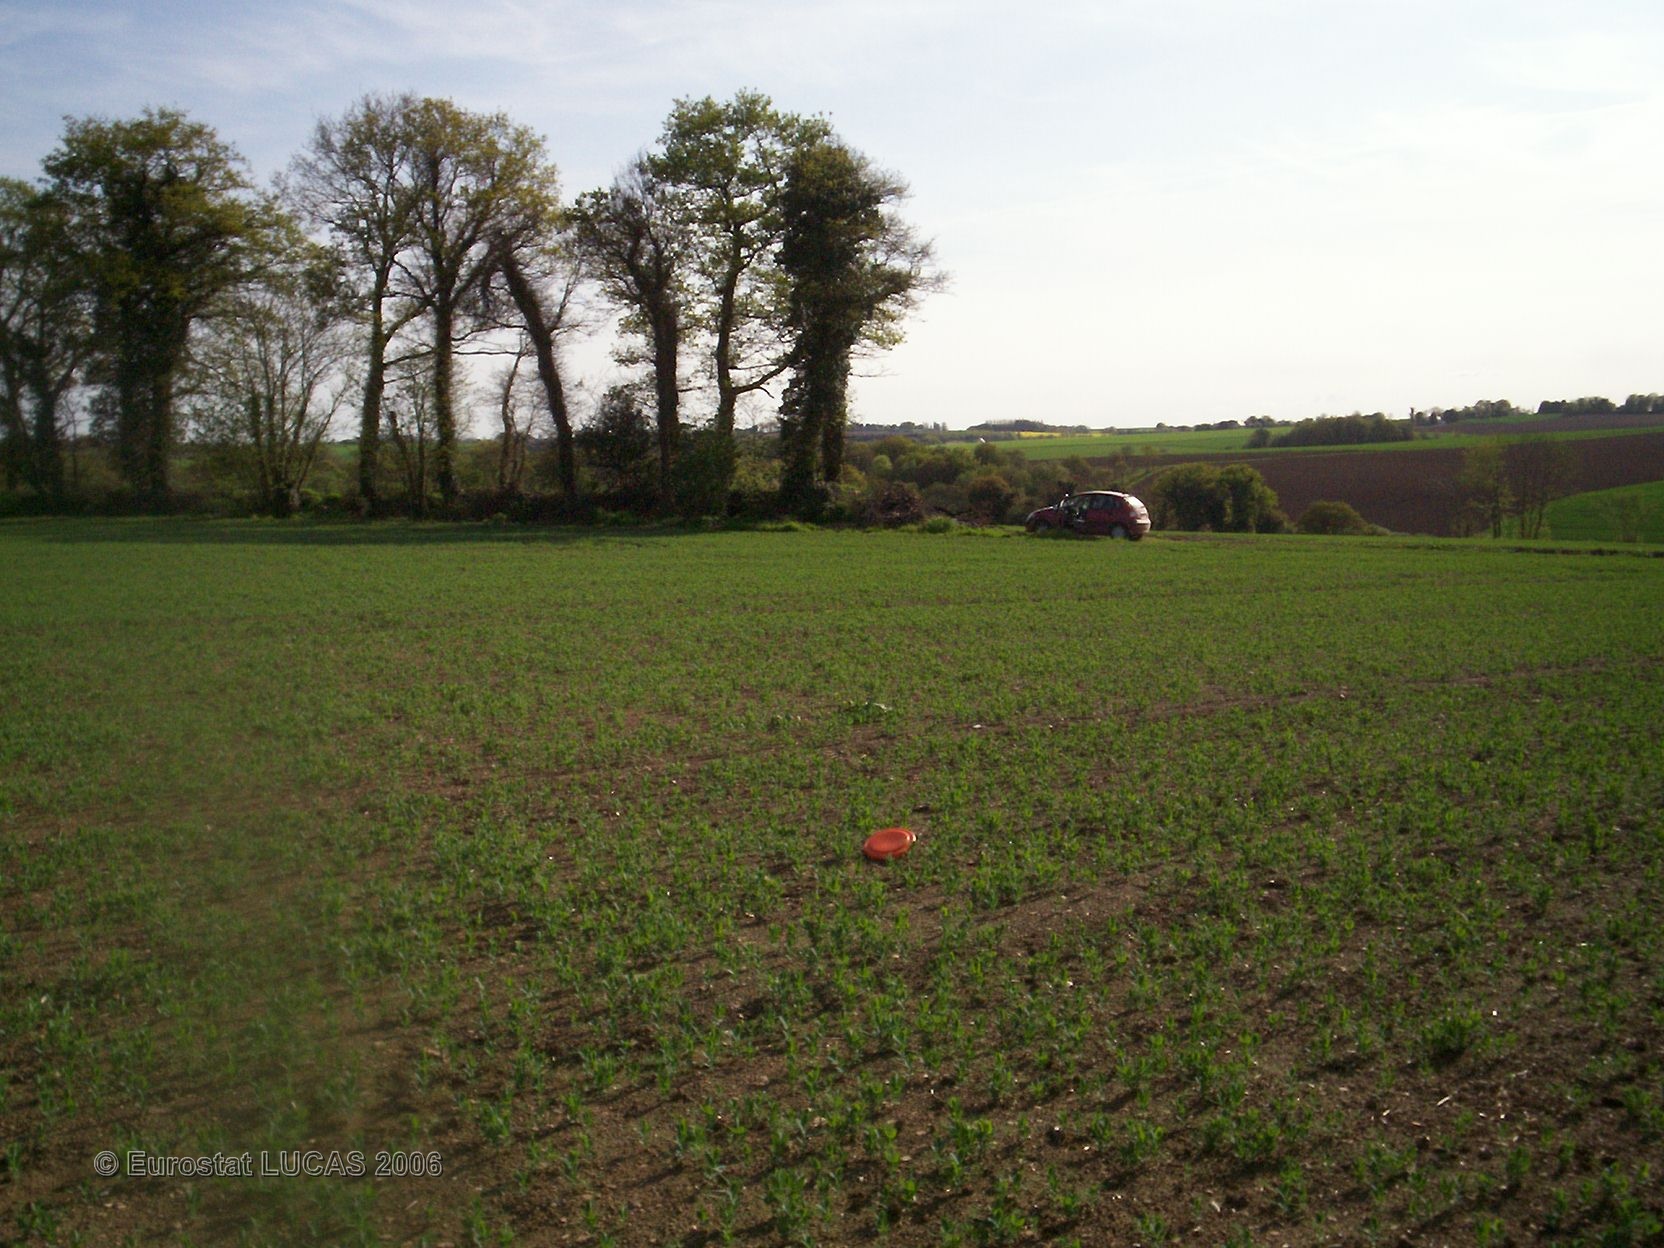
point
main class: Cropland
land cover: Dry pulses
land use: Agriculture (excluding fallow land and kitchen gardens)
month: May
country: FR
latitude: 47.9706
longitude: -2.9119
